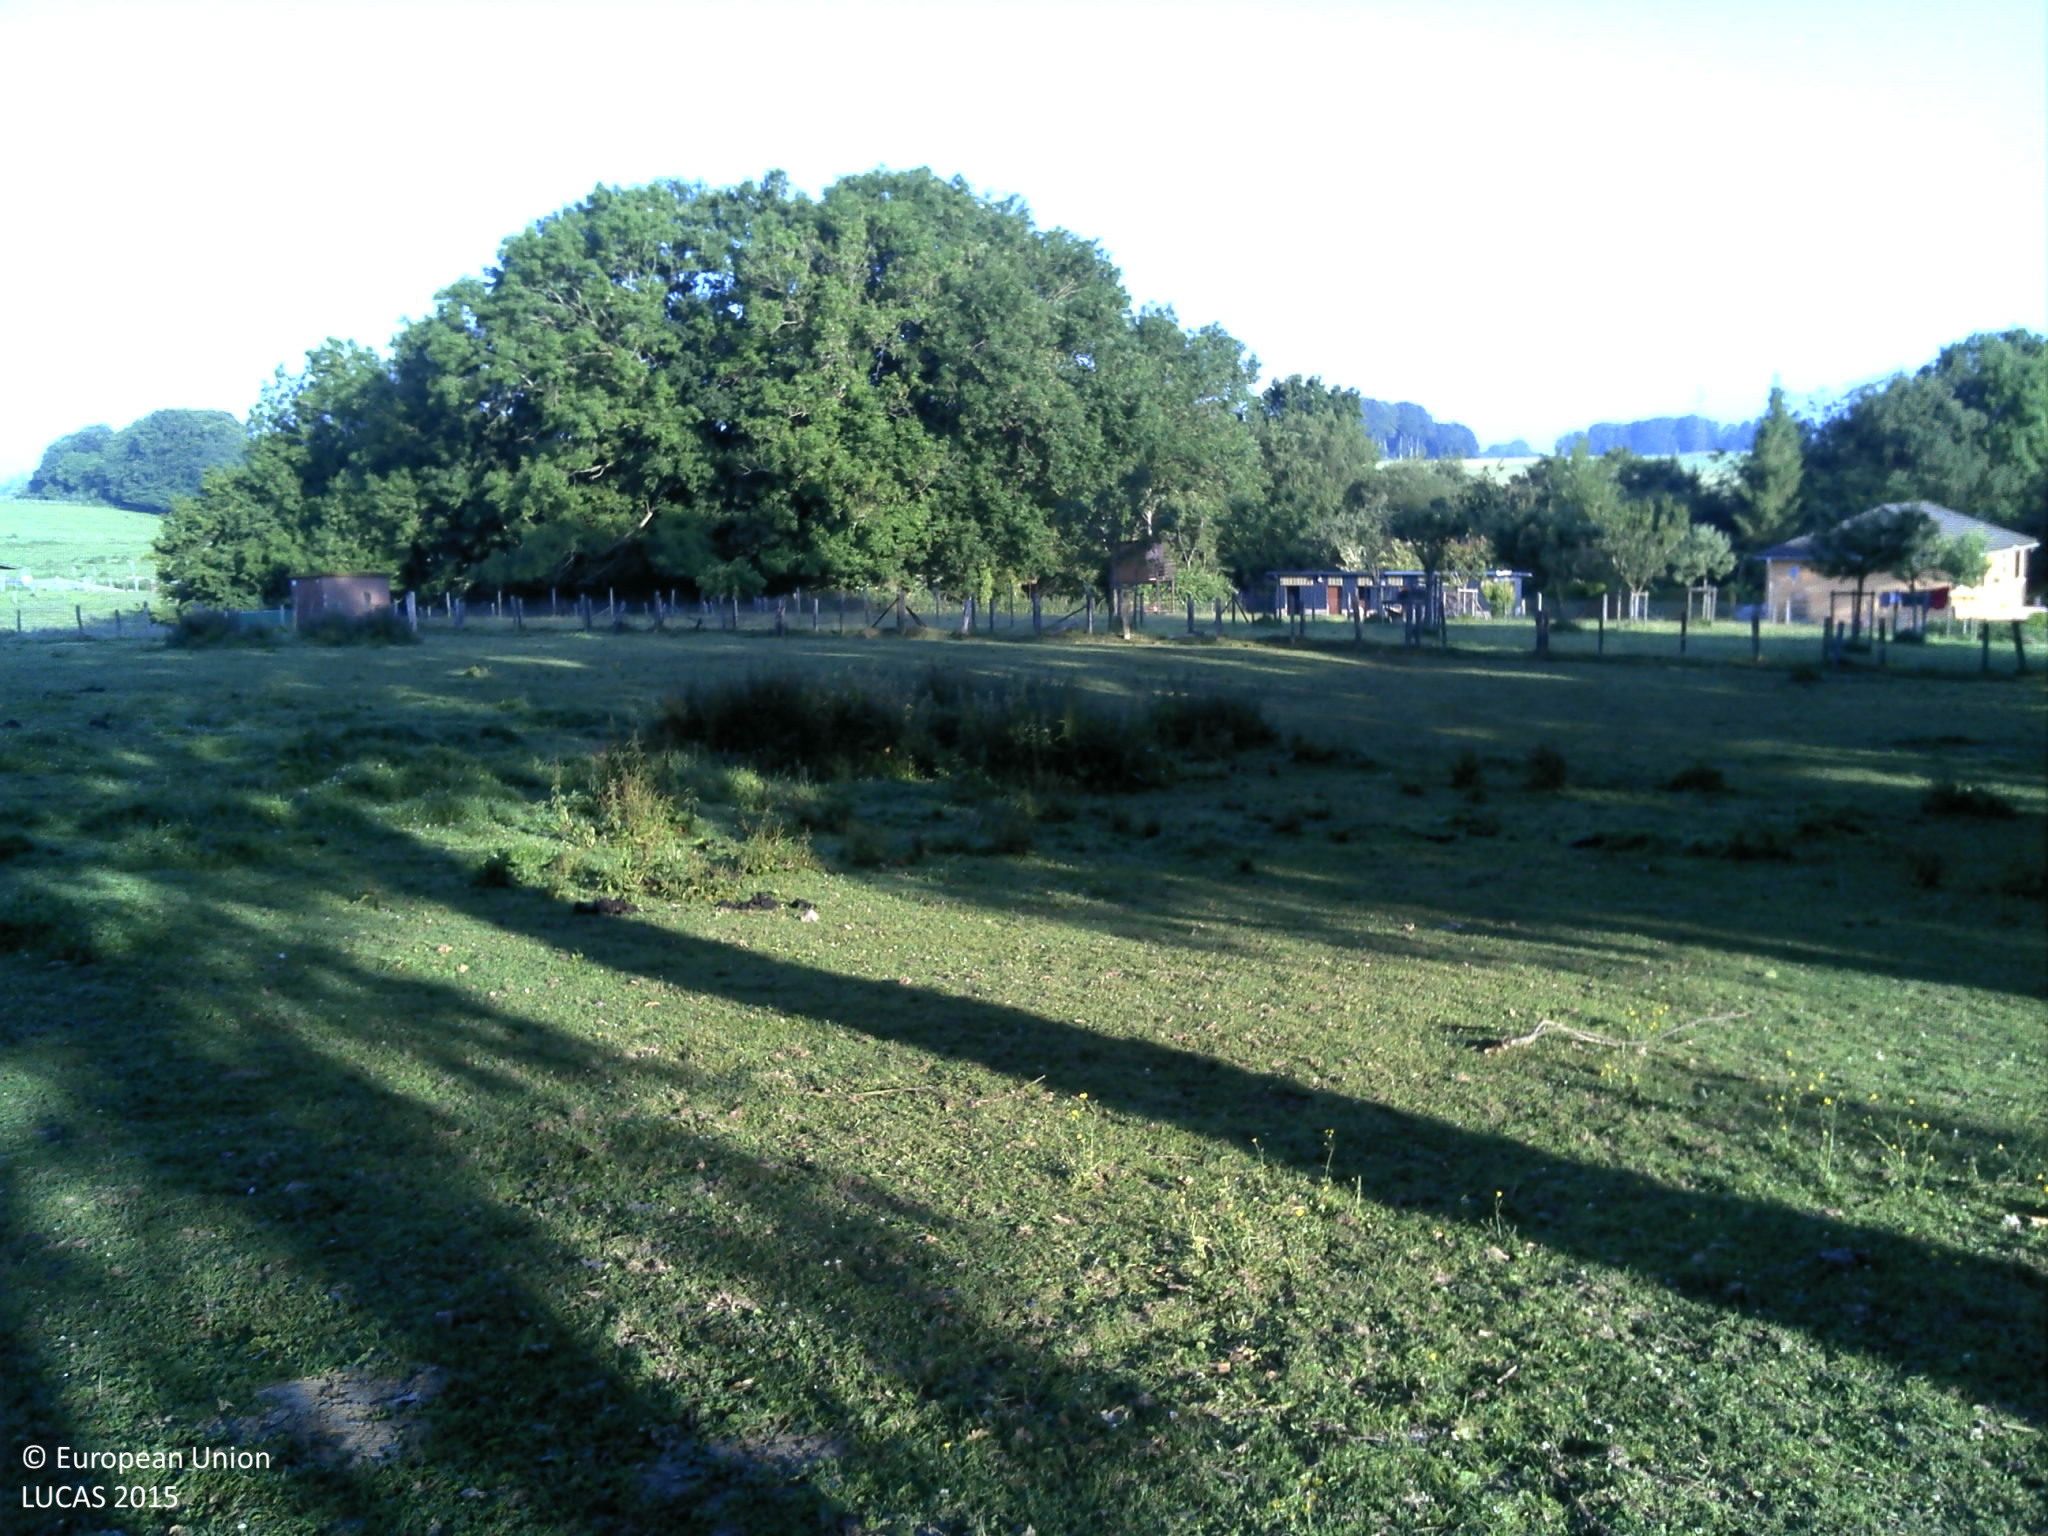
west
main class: Grassland
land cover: Grassland without tree/shrub cover
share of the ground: > 75 %
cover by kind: herbaceous plants 100 %
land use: Agriculture (excluding fallow land and kitchen gardens)
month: June
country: FR
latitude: 49.5602
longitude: 0.3915
